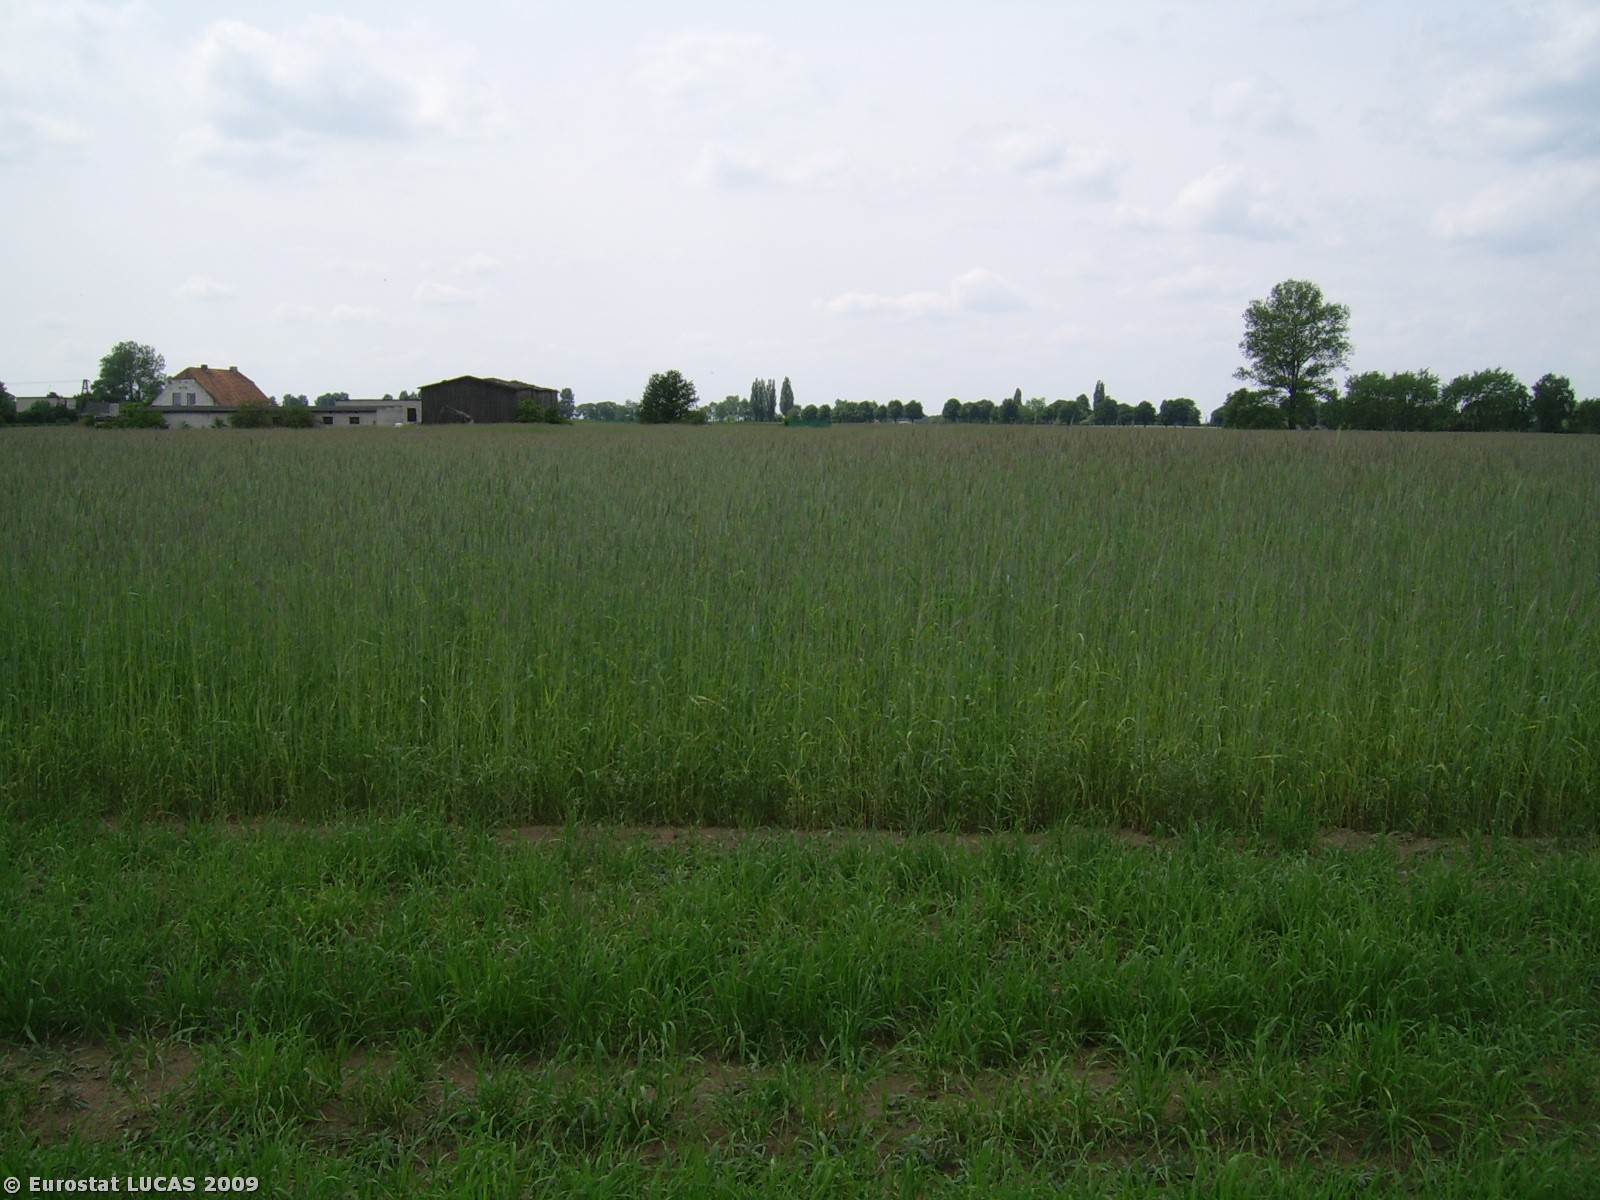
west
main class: Cropland
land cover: Barley
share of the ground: 50 - 75 %
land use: Agriculture (excluding fallow land and kitchen gardens)
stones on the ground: < 10 %
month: May
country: PL
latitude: 52.8844
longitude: 17.9956
